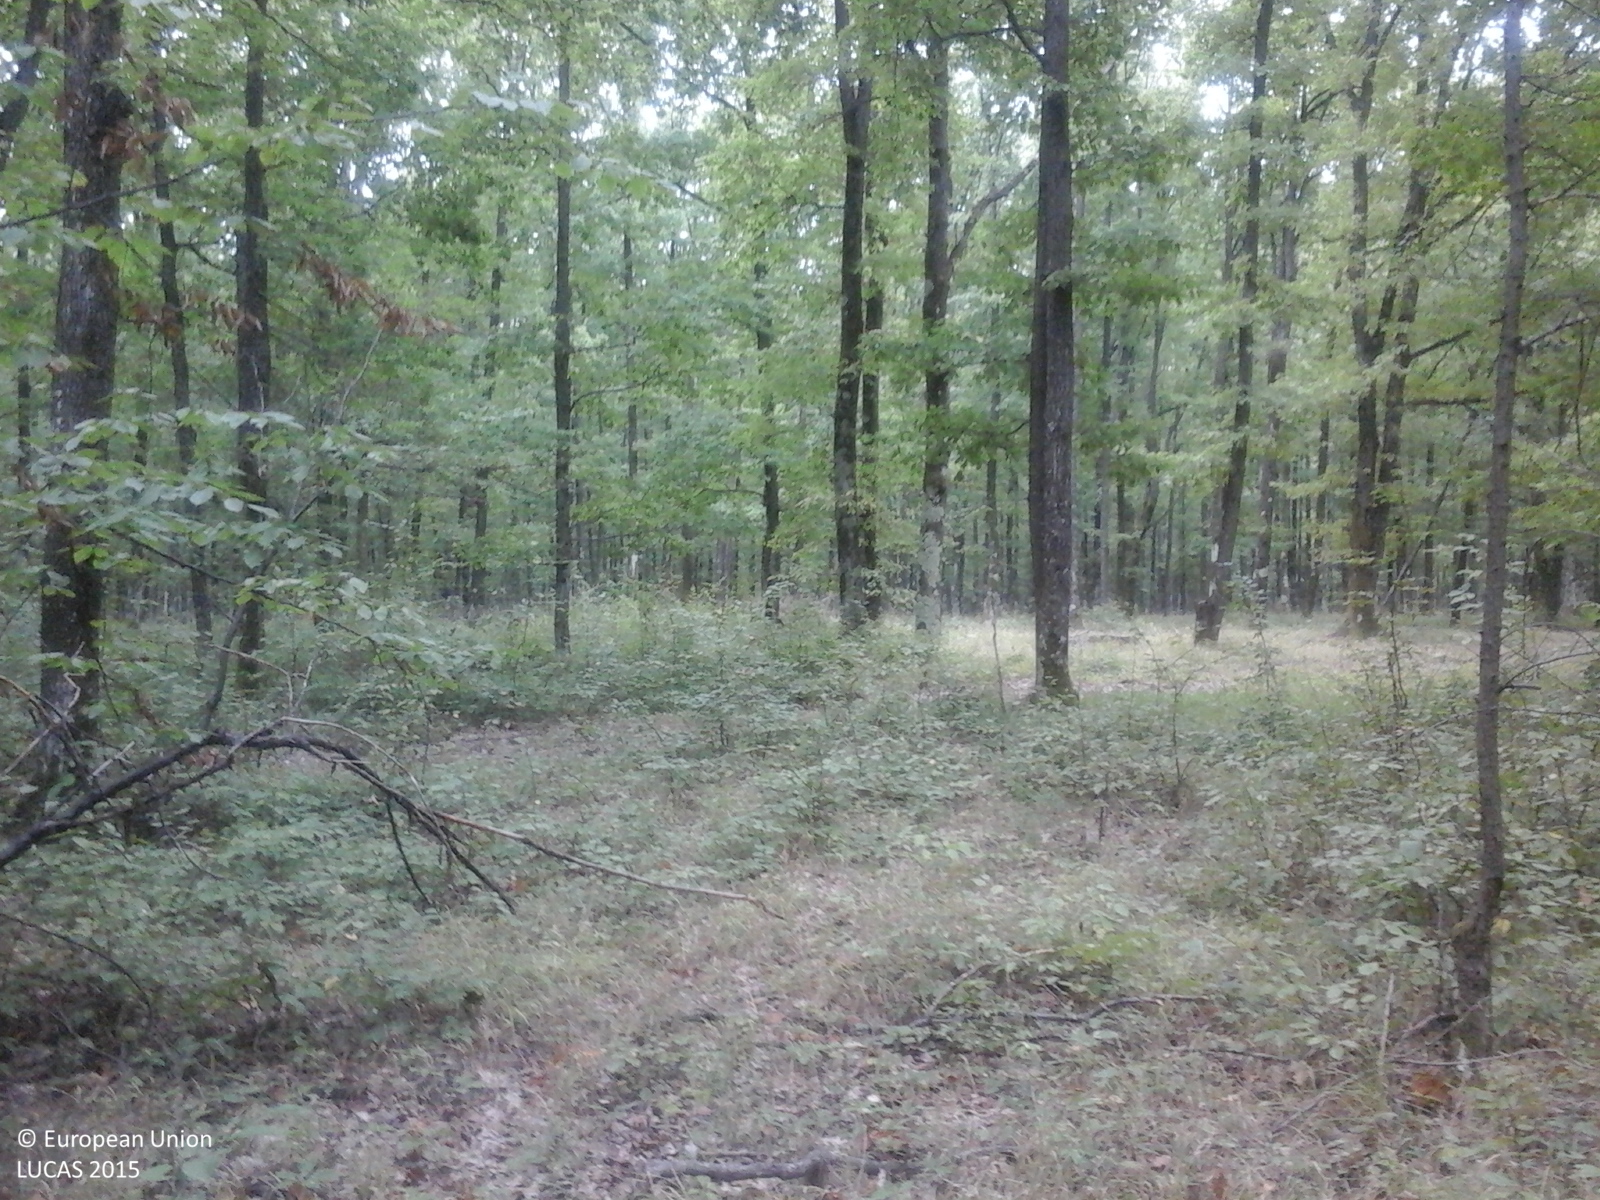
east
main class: Woodland
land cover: Broadleaved woodland
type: acidophilous oak and oak-birch forest
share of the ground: > 75 %
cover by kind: broadleaved forest trees 100 %
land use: Forestry
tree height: > 5 m
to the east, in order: Broadleaved woodland
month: September
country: RO
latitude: 44.9475
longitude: 23.3240
